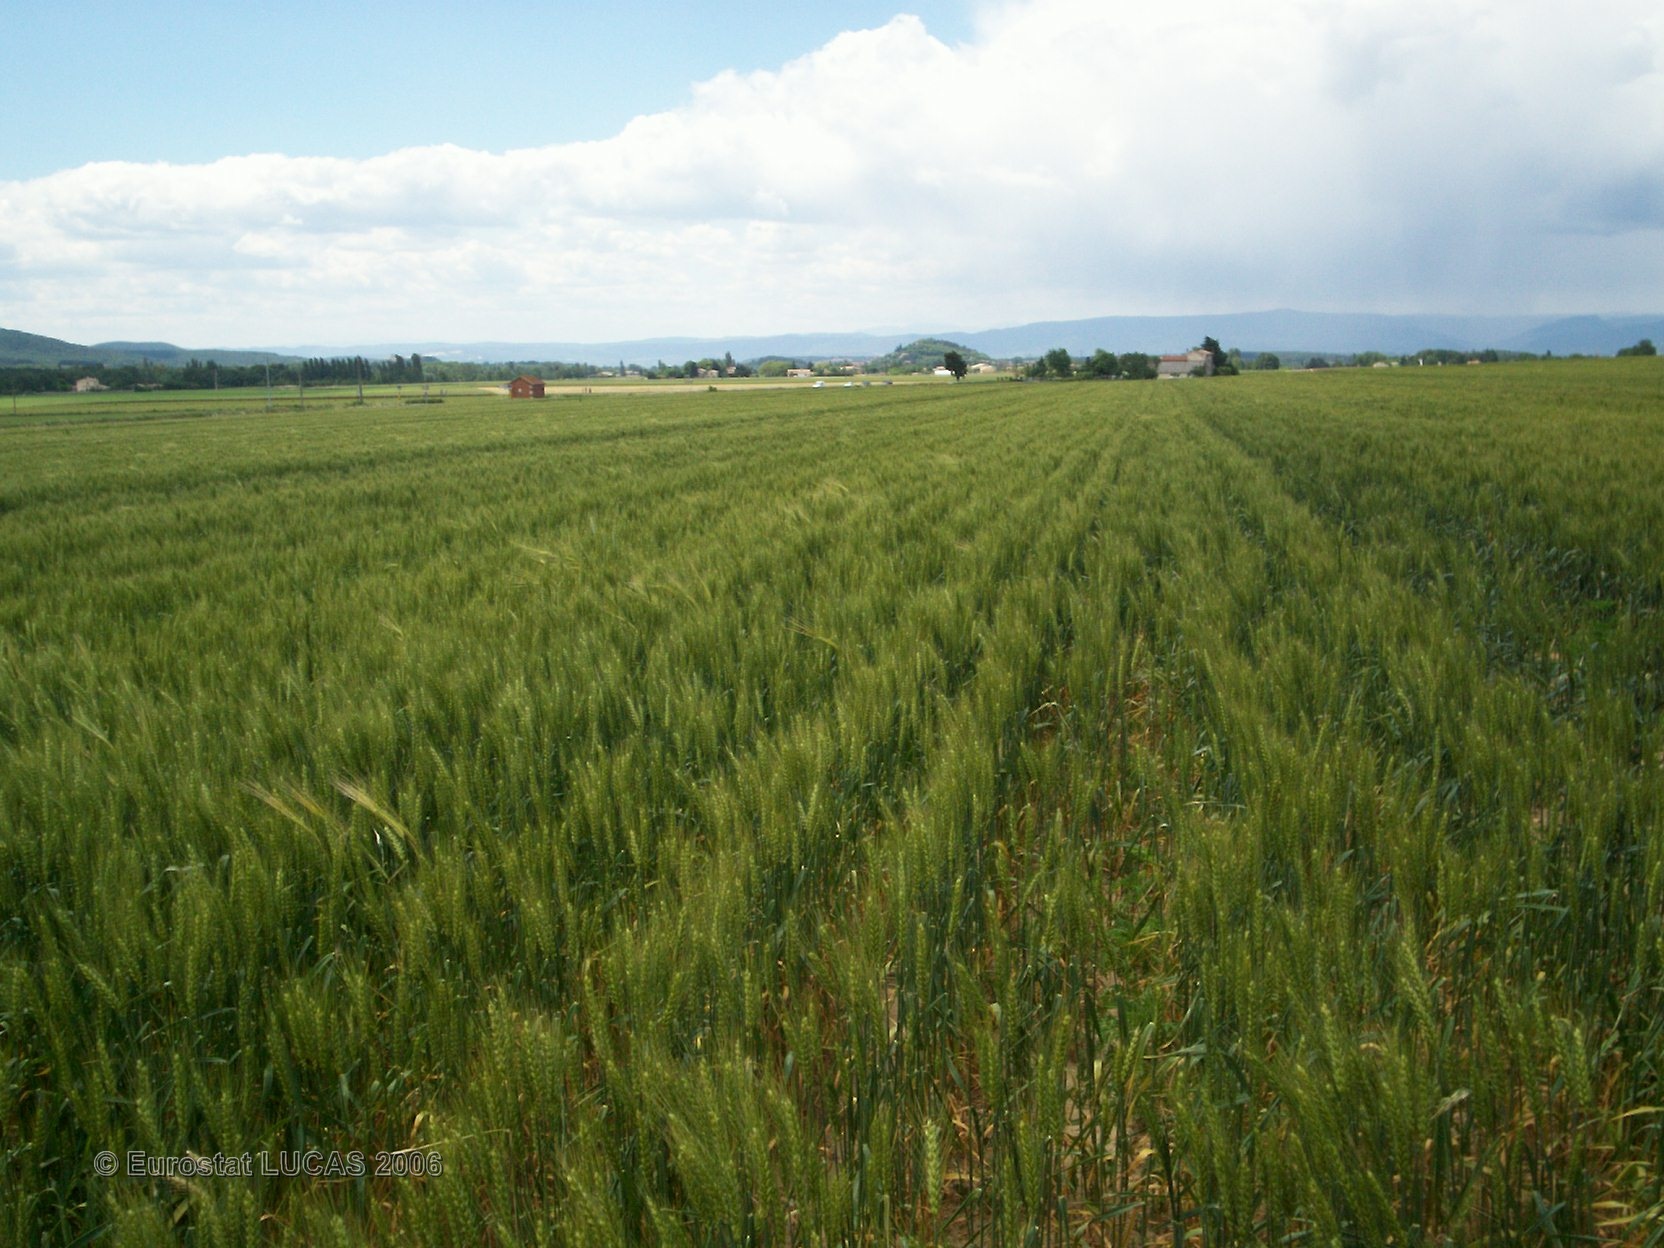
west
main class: Cropland
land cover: Durum wheat
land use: Agriculture (excluding fallow land and kitchen gardens)
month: May
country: FR
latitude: 44.5508
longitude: 4.9087
